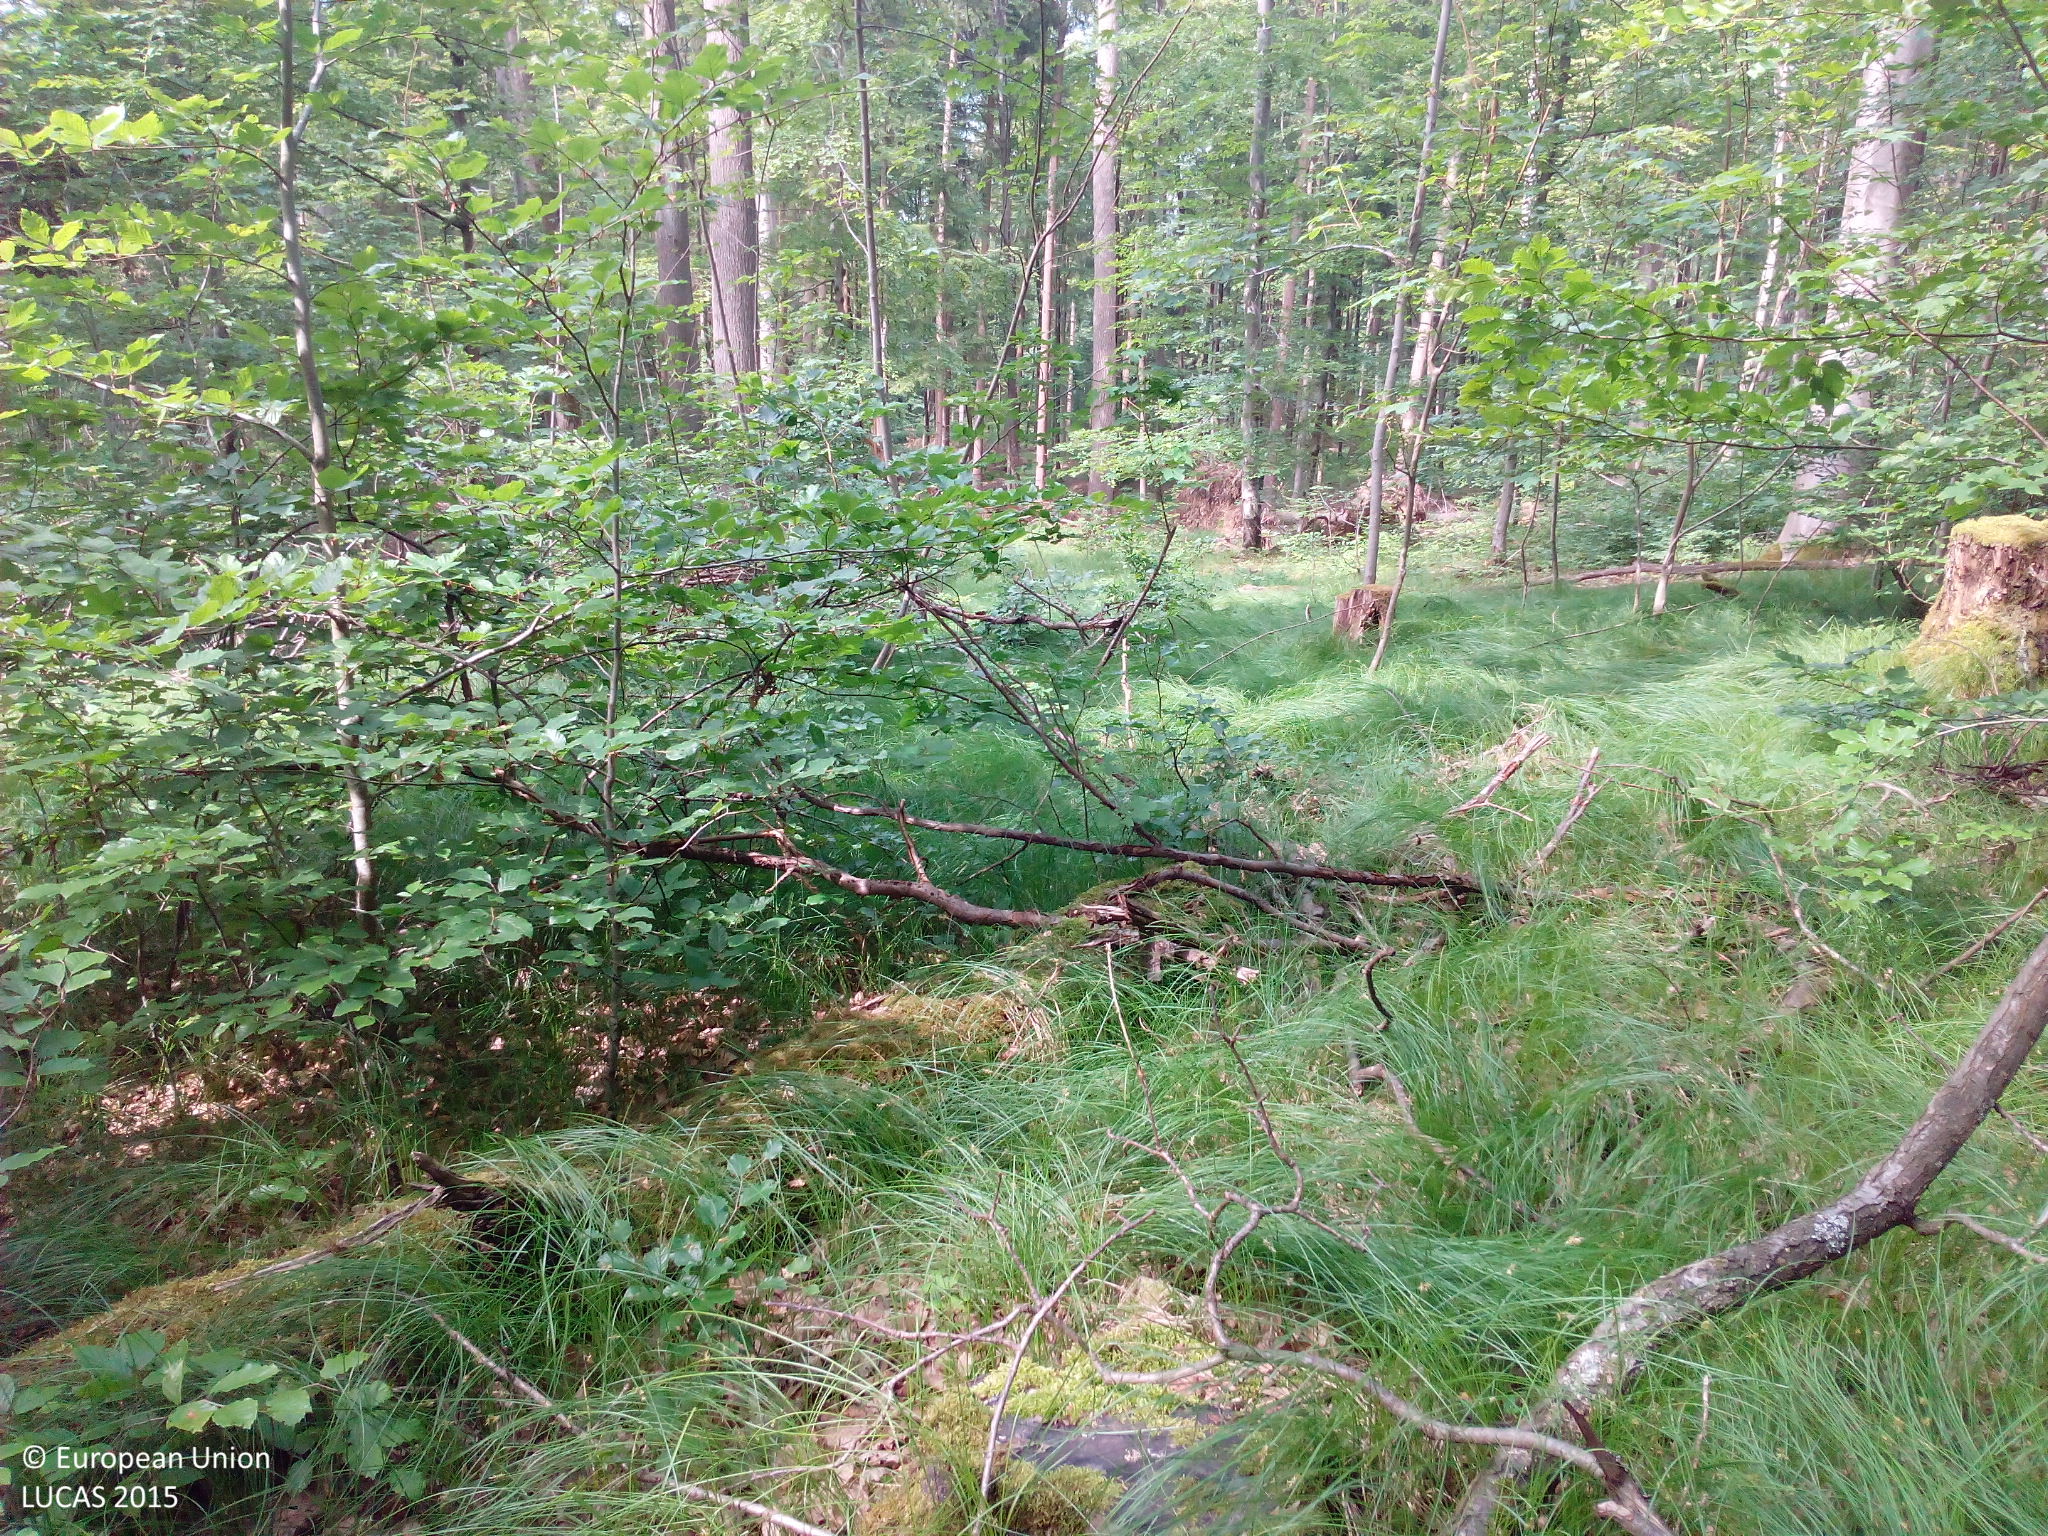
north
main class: Woodland
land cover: Broadleaved woodland
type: mesophytic deciduous forest
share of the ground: > 75 %
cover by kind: broadleaved forest trees 85 %, shrubs 10 %, herbaceous plants 5 %
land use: Forestry
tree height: > 5 m
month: June
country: DE
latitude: 48.7438
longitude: 9.4155
